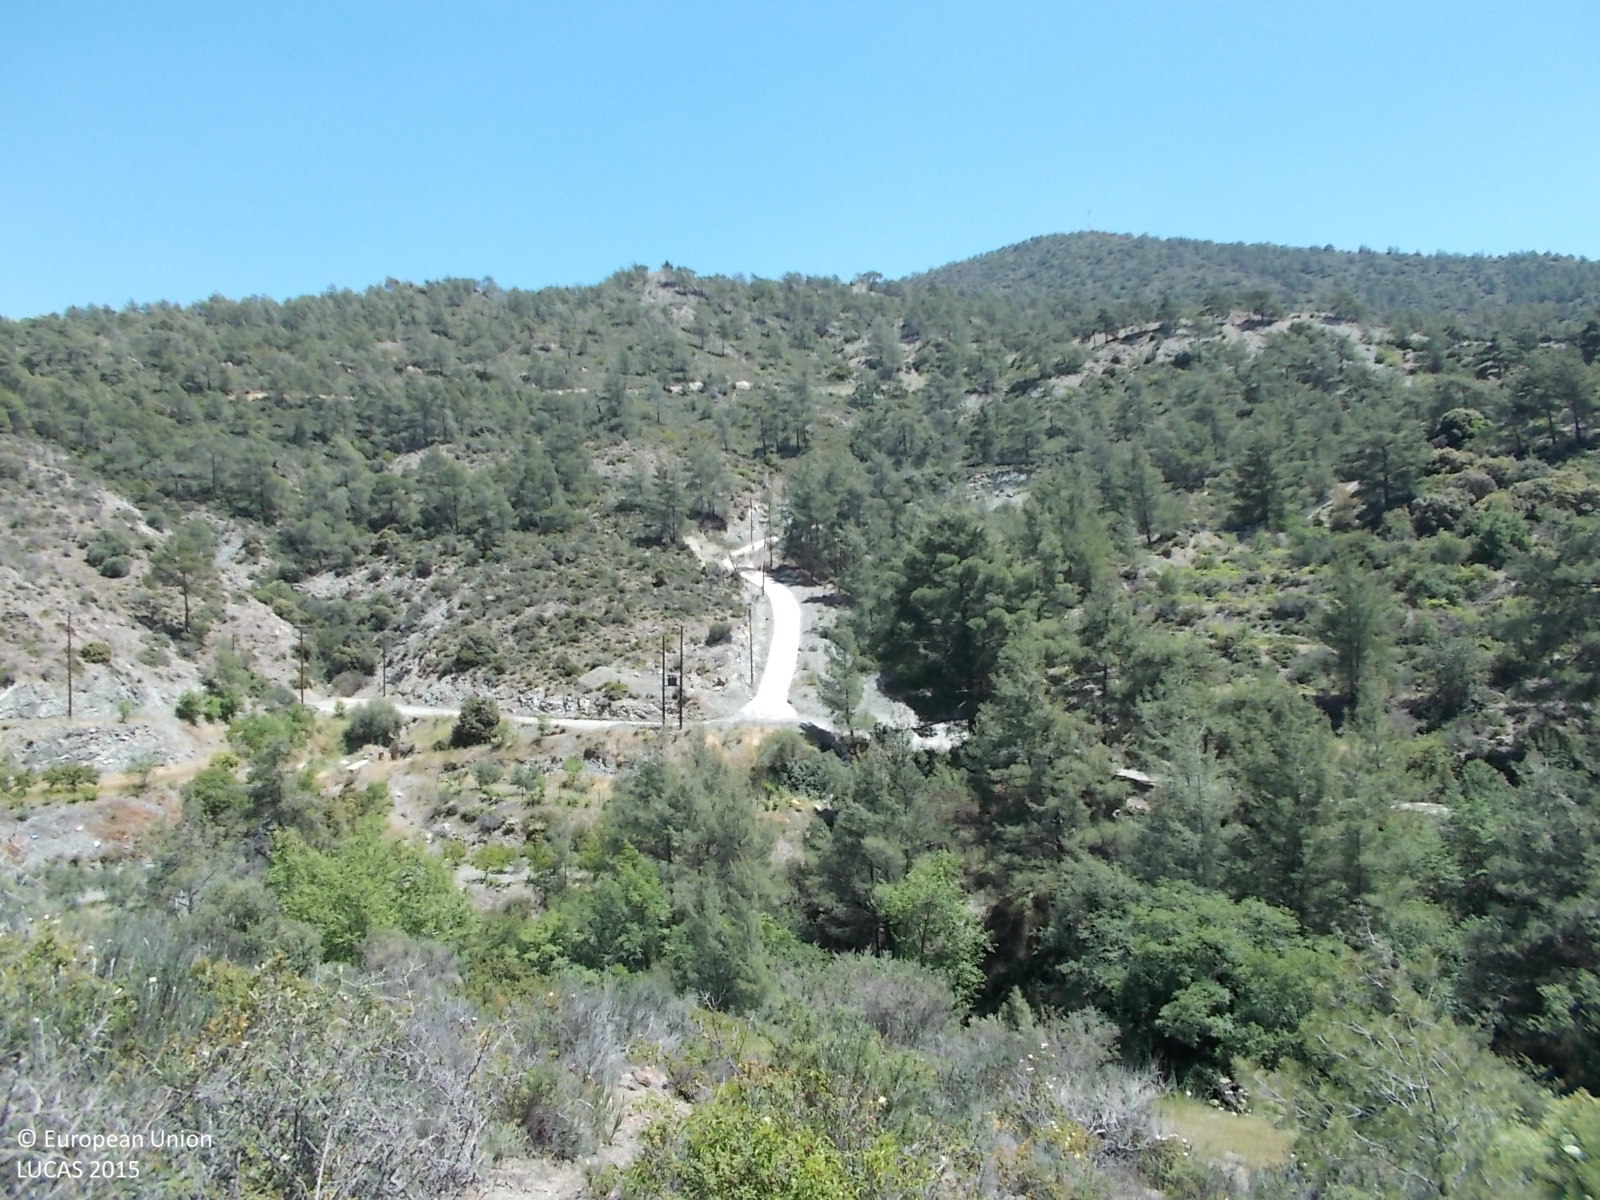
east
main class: Shrubland
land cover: Shrubland with sparse tree cover
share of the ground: > 75 %
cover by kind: shrubs 75 %, unconsolidated bare surface 20 %, broadleaved forest trees 5 %
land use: Semi-natural and natural areas not in use
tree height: < 5 m
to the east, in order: Shrubland with sparse tree cover; Tracks; Shrubland with sparse tree cover; Rivers and streams; Shrubland with sparse tree cover; Pine dominated coniferous woodland; Olive groves; Paved roads, cycling and walking lanes; Electric lines; Shrubland with sparse tree cover; Paved roads, cycling and walking lanes; Rocks and stones
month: May
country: CY
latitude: 34.8236
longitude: 33.0308
